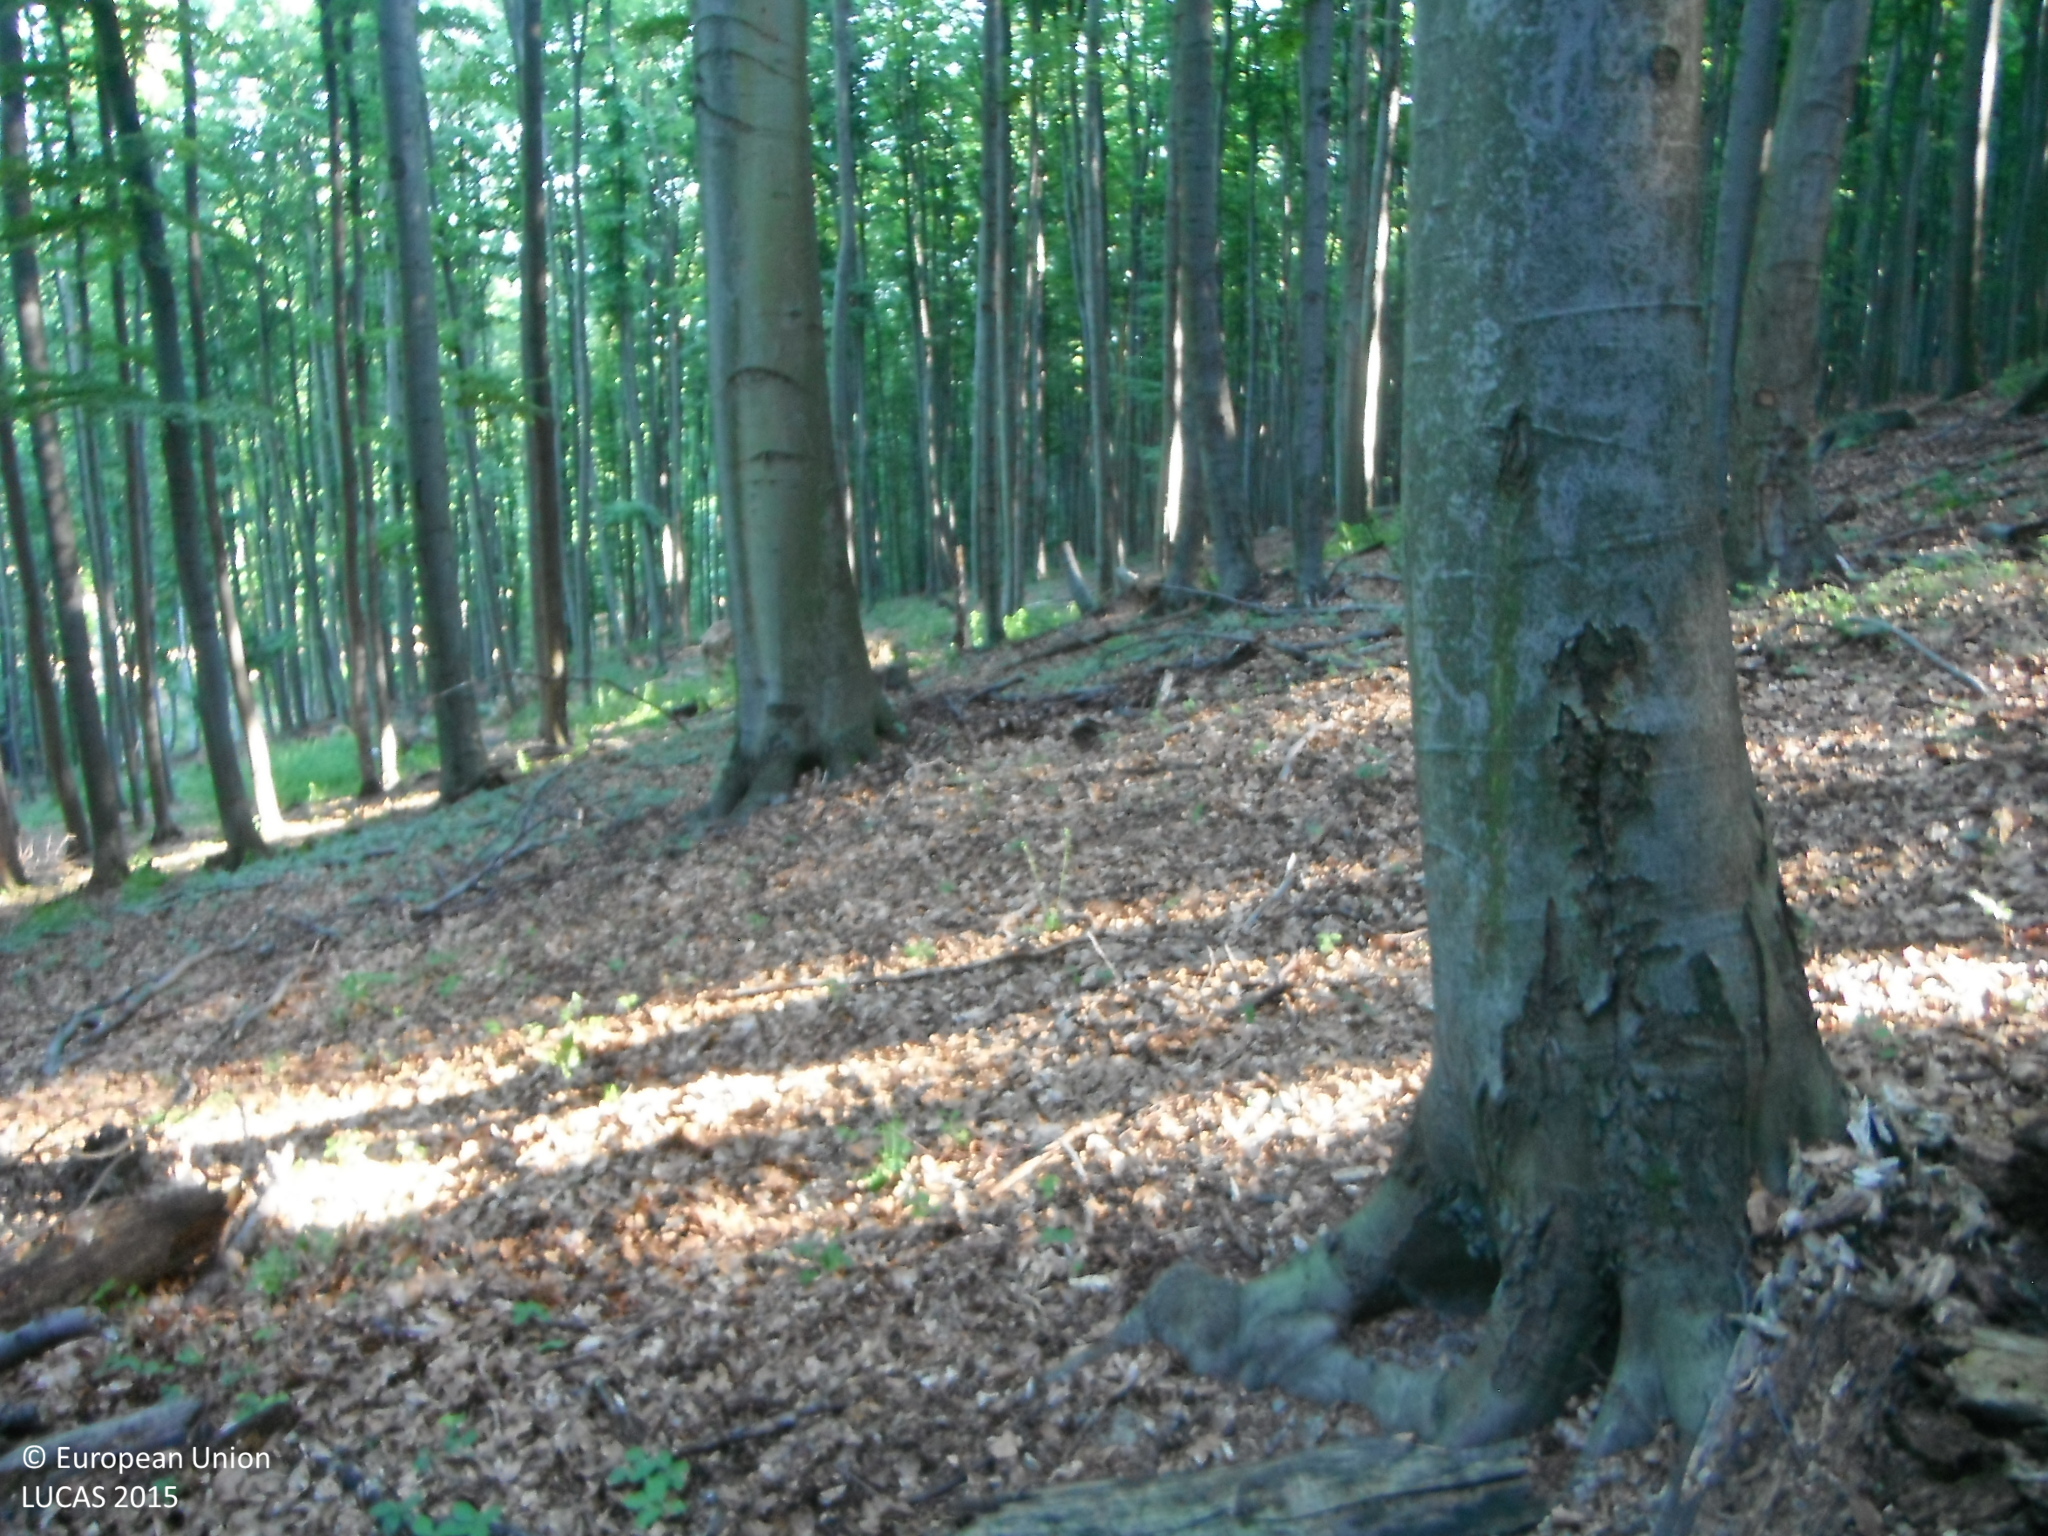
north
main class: Woodland
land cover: Broadleaved woodland
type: beech forest
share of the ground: > 75 %
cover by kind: broadleaved forest trees 80 %, shrubs 15 %, unconsolidated bare surface 5 %
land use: Forestry
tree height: > 5 m
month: June
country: SK
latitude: 48.5061
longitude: 18.3127
